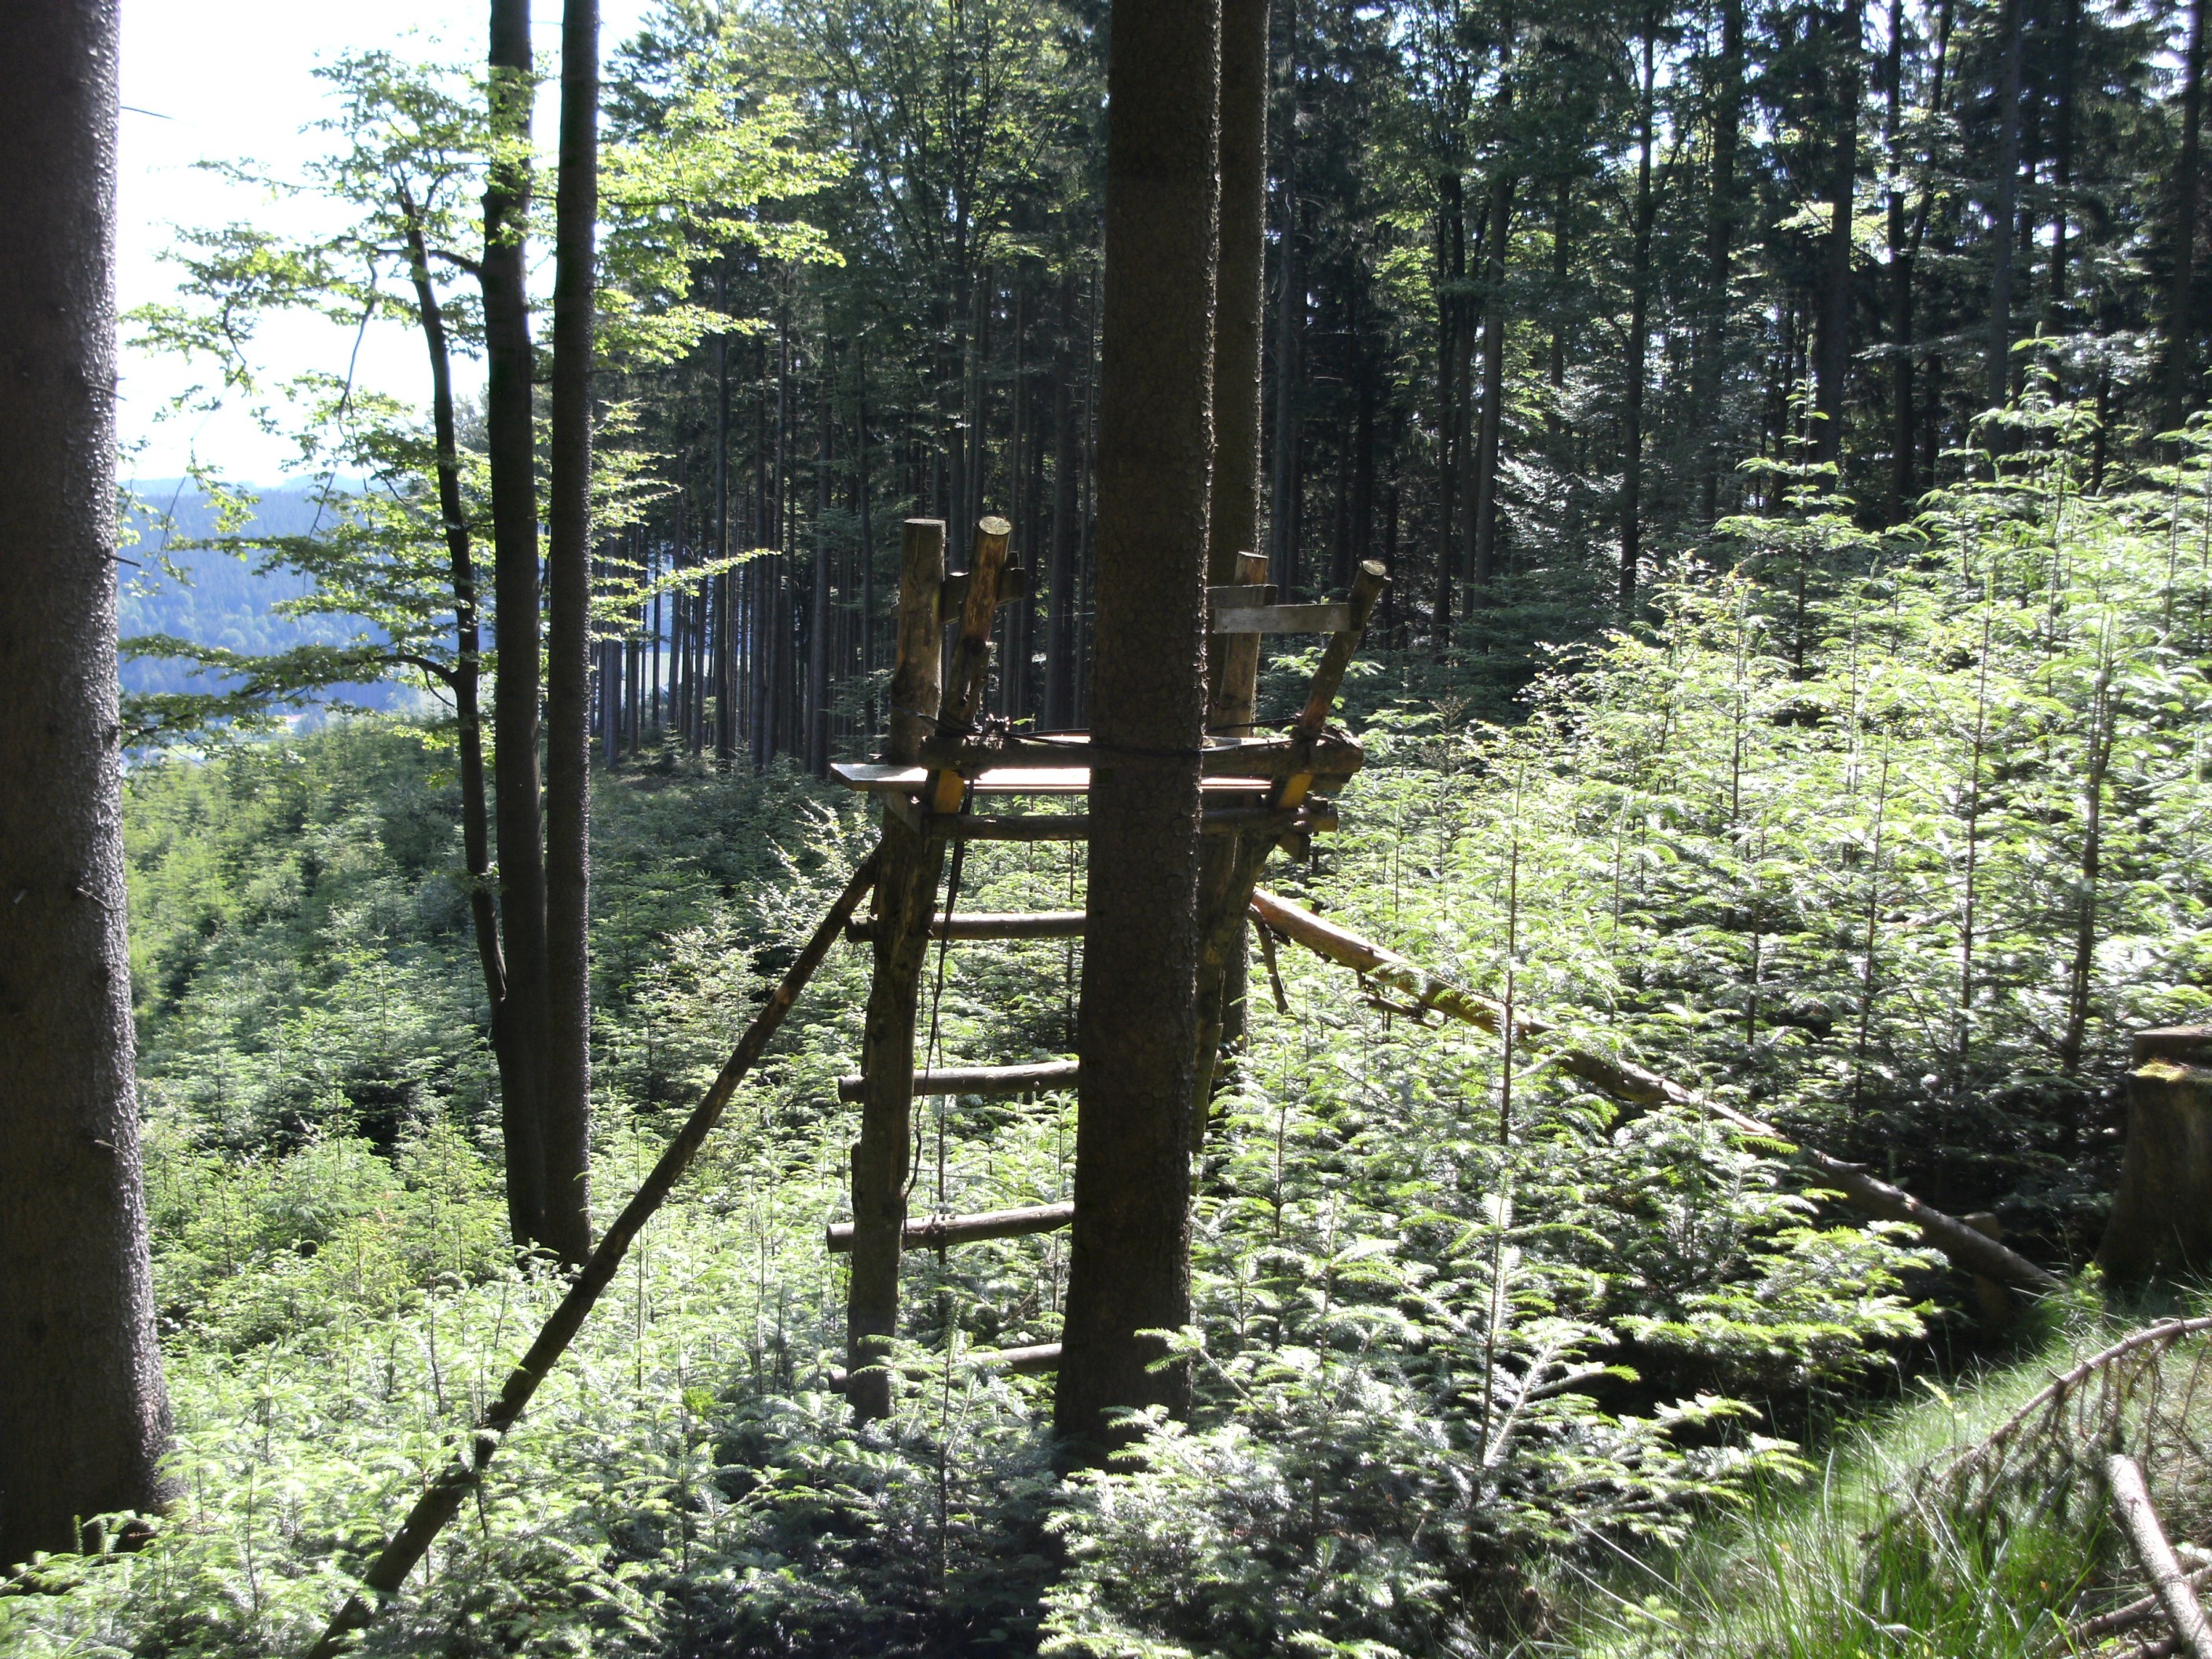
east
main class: Woodland
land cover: Other mixed woodland
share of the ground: > 75 %
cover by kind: coniferous forest trees 55 %, broadleaved forest trees 35 %, herbaceous plants 10 %
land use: Forestry
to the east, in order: Tracks; Other mixed woodland; Other coniferous woodland; Tracks; Other coniferous woodland; Spruce dominated mixed woodland; Tracks; Spruce dominated mixed woodland; Tracks; Spruce dominated mixed woodland
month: June
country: AT
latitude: 48.1112
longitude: 13.5854
